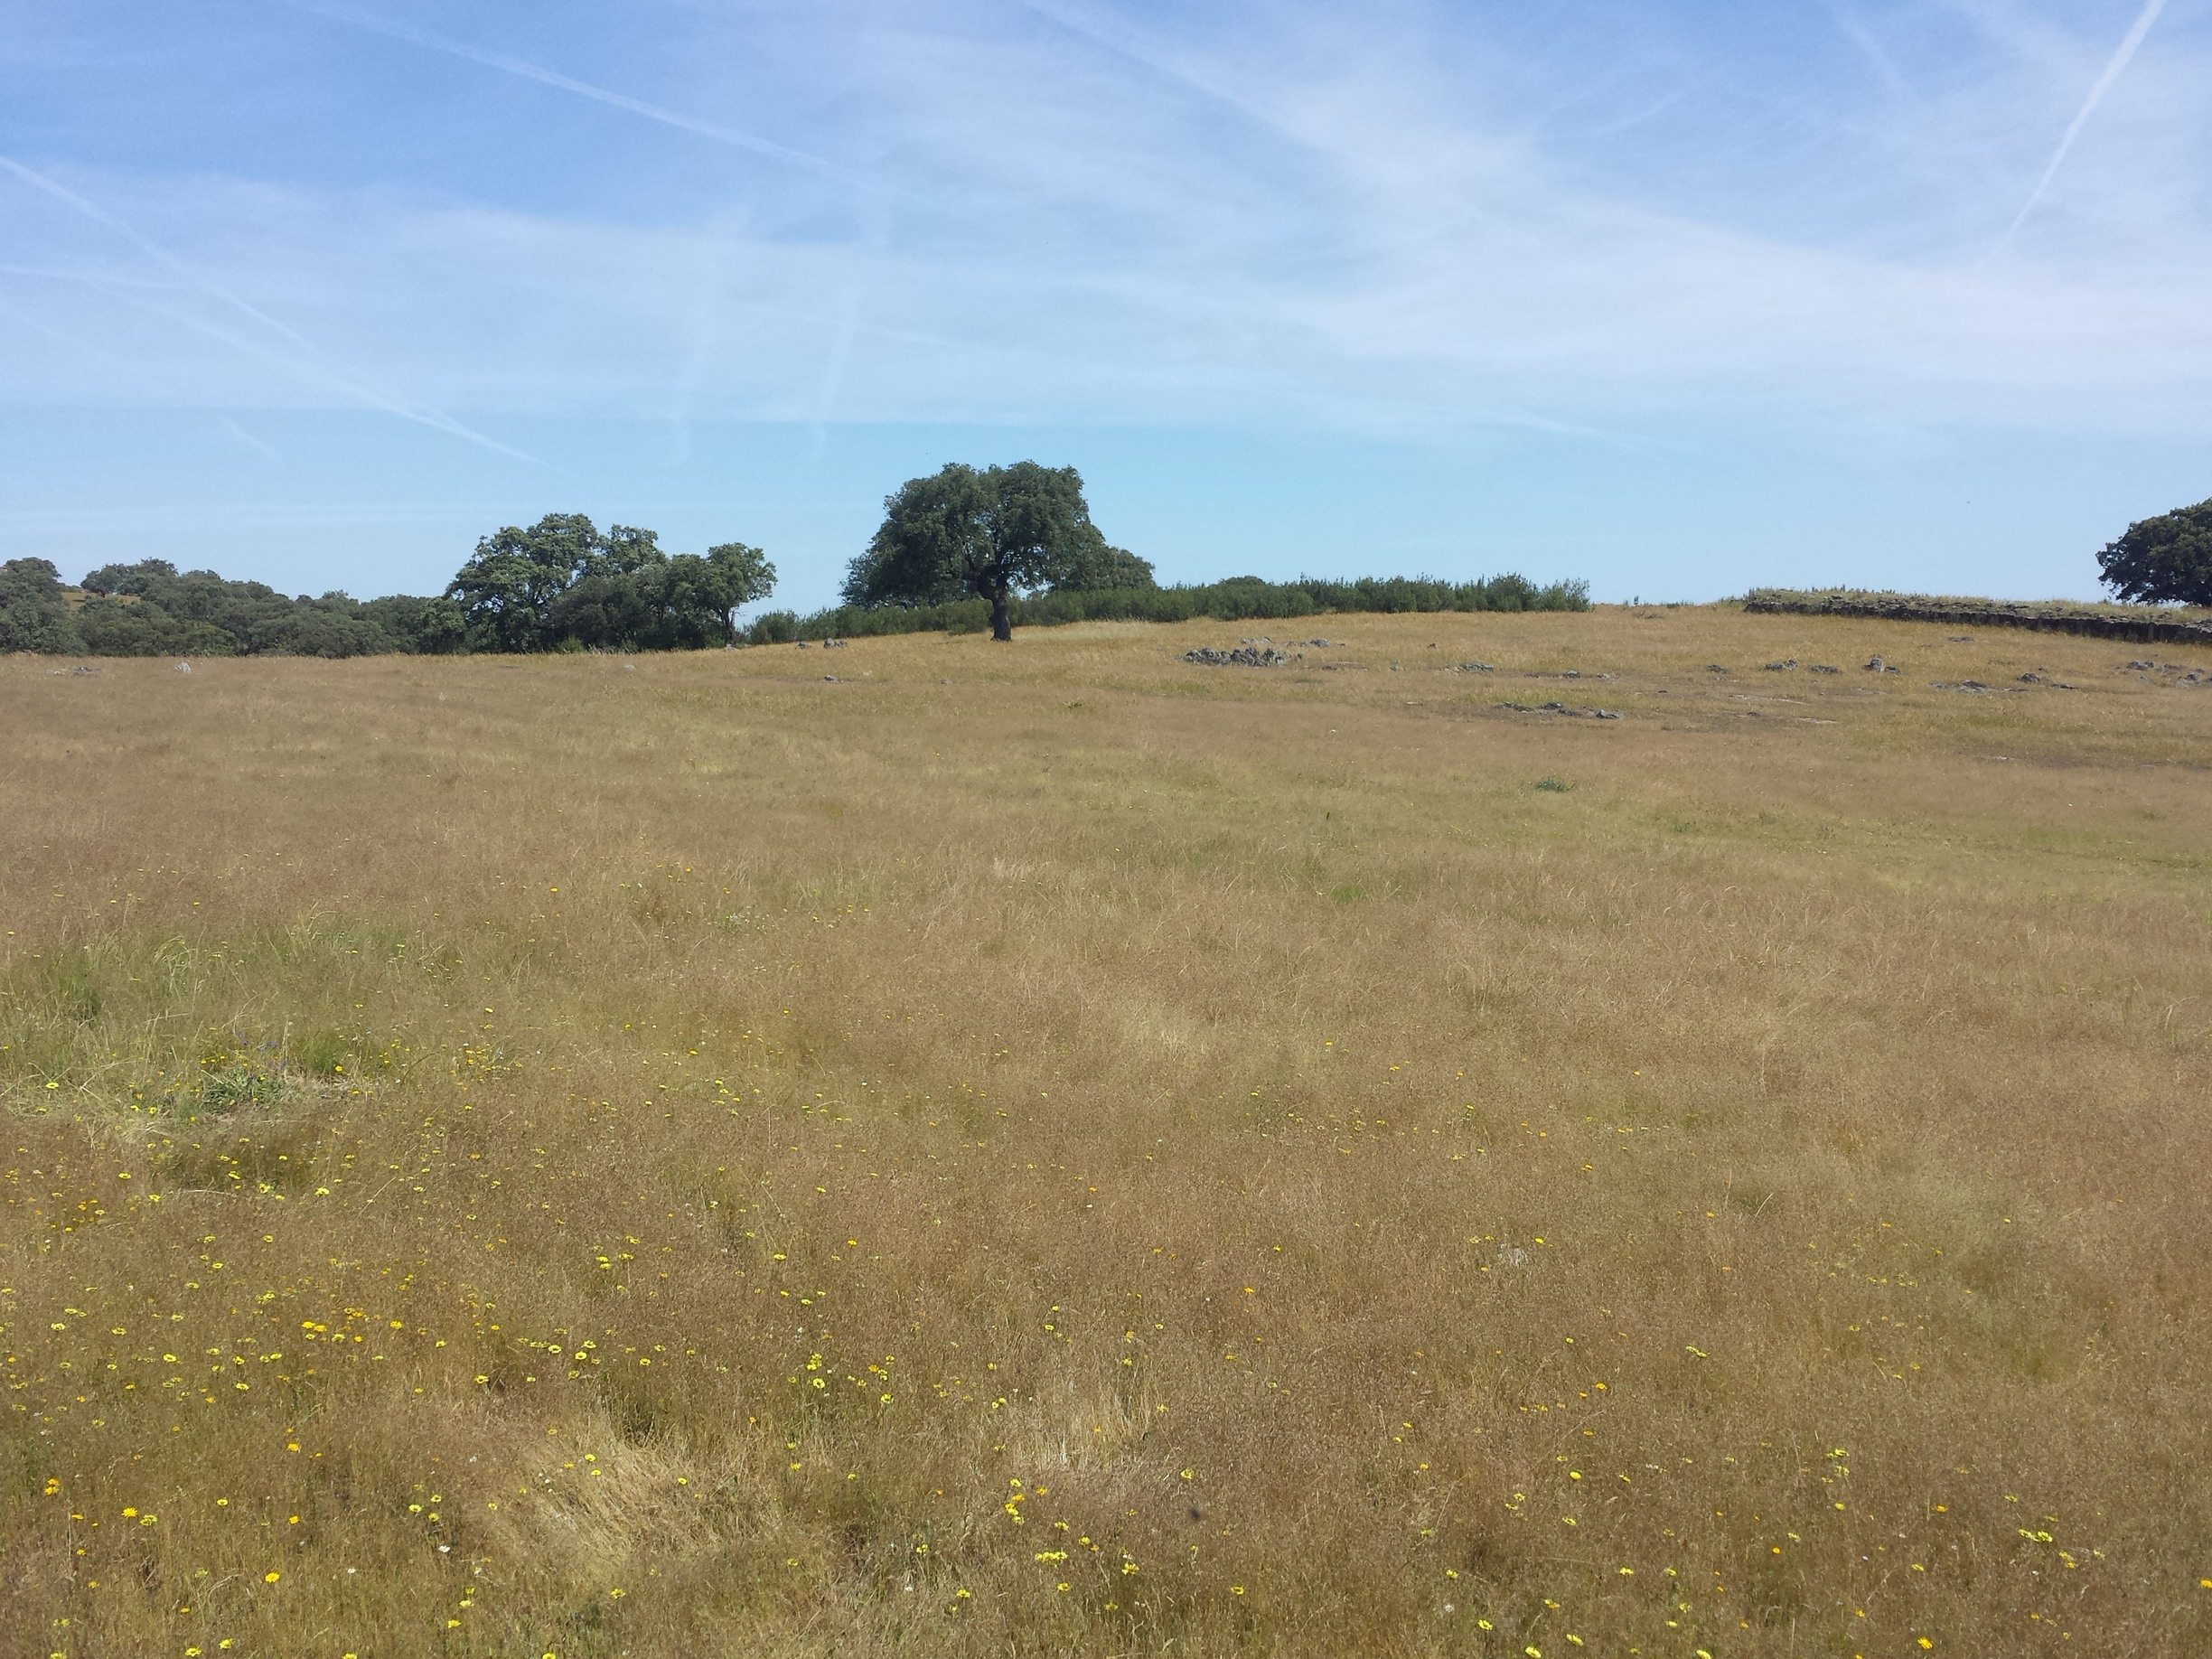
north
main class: Grassland
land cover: Grassland without tree/shrub cover
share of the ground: > 75 %
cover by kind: herbaceous plants 100 %
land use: Agriculture (excluding fallow land and kitchen gardens)
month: May
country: ES
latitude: 39.6154
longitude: -7.1280
